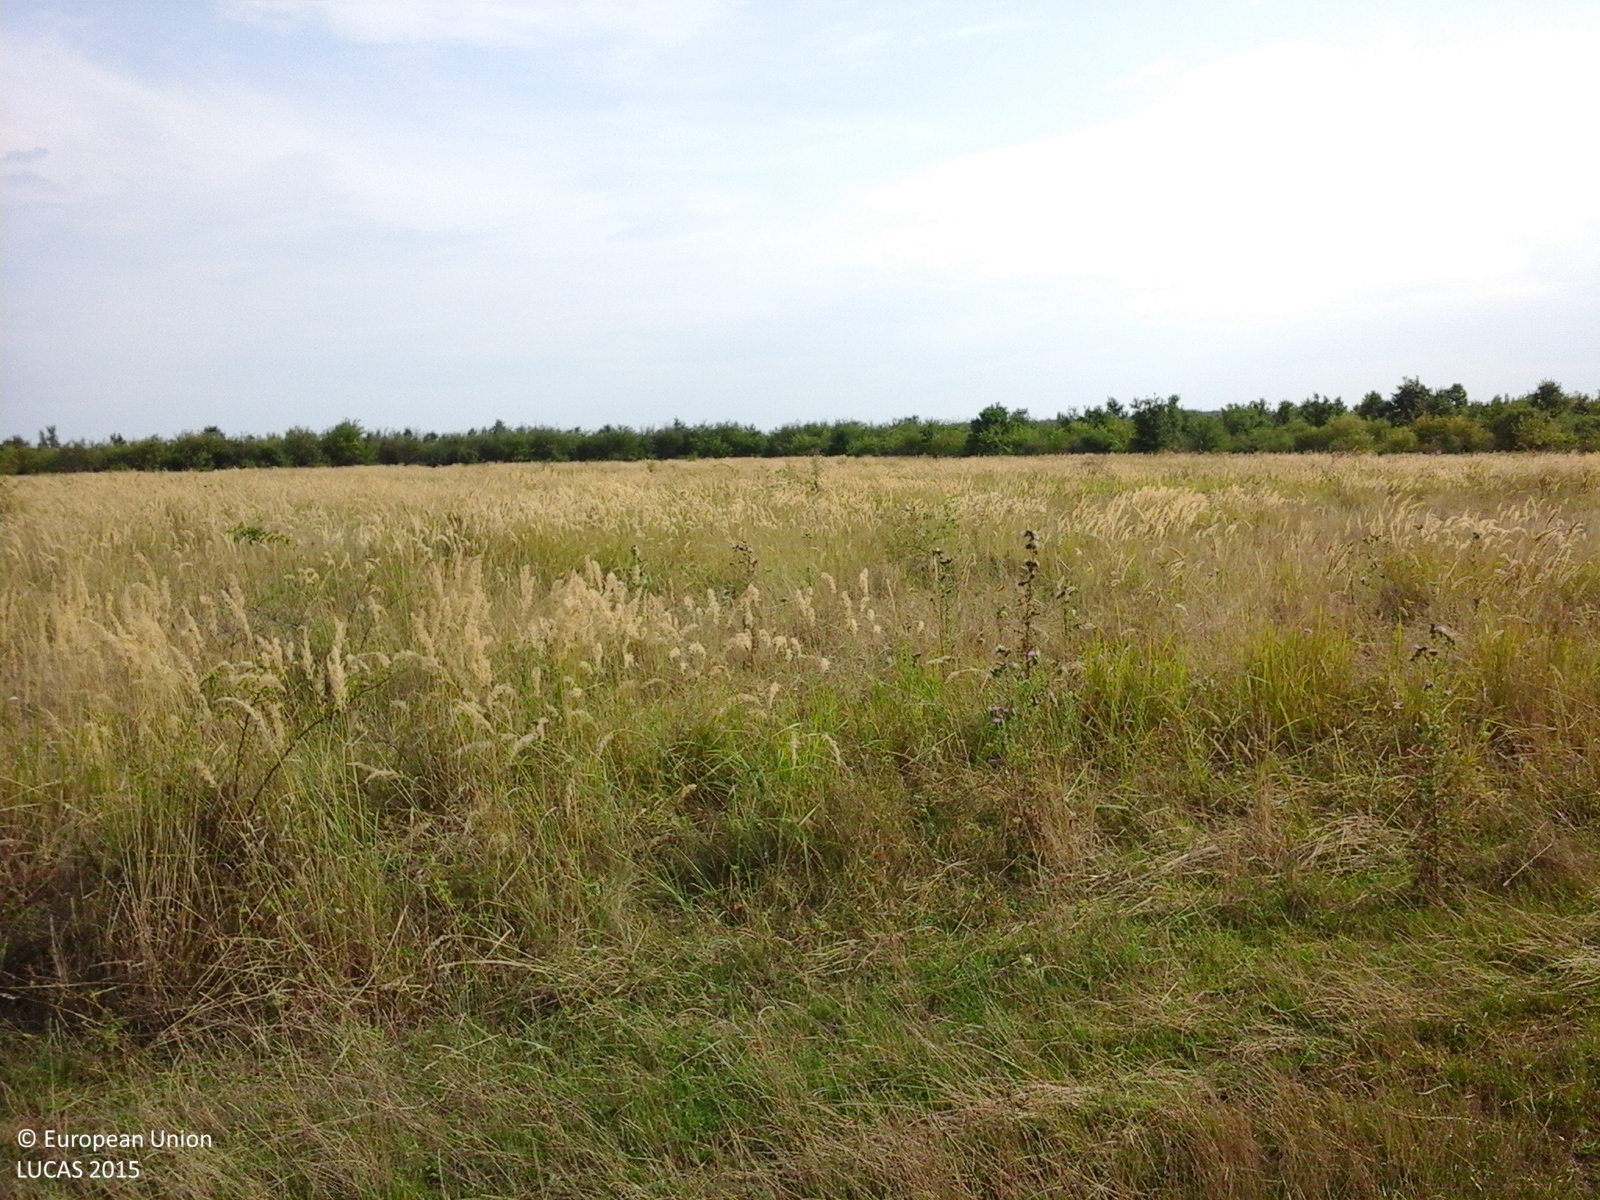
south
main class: Cropland
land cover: Apple fruit
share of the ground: > 75 %
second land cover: Grassland without tree/shrub cover
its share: > 75 %
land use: Agriculture (excluding fallow land and kitchen gardens)
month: August
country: RO
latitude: 46.0570
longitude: 21.6576
